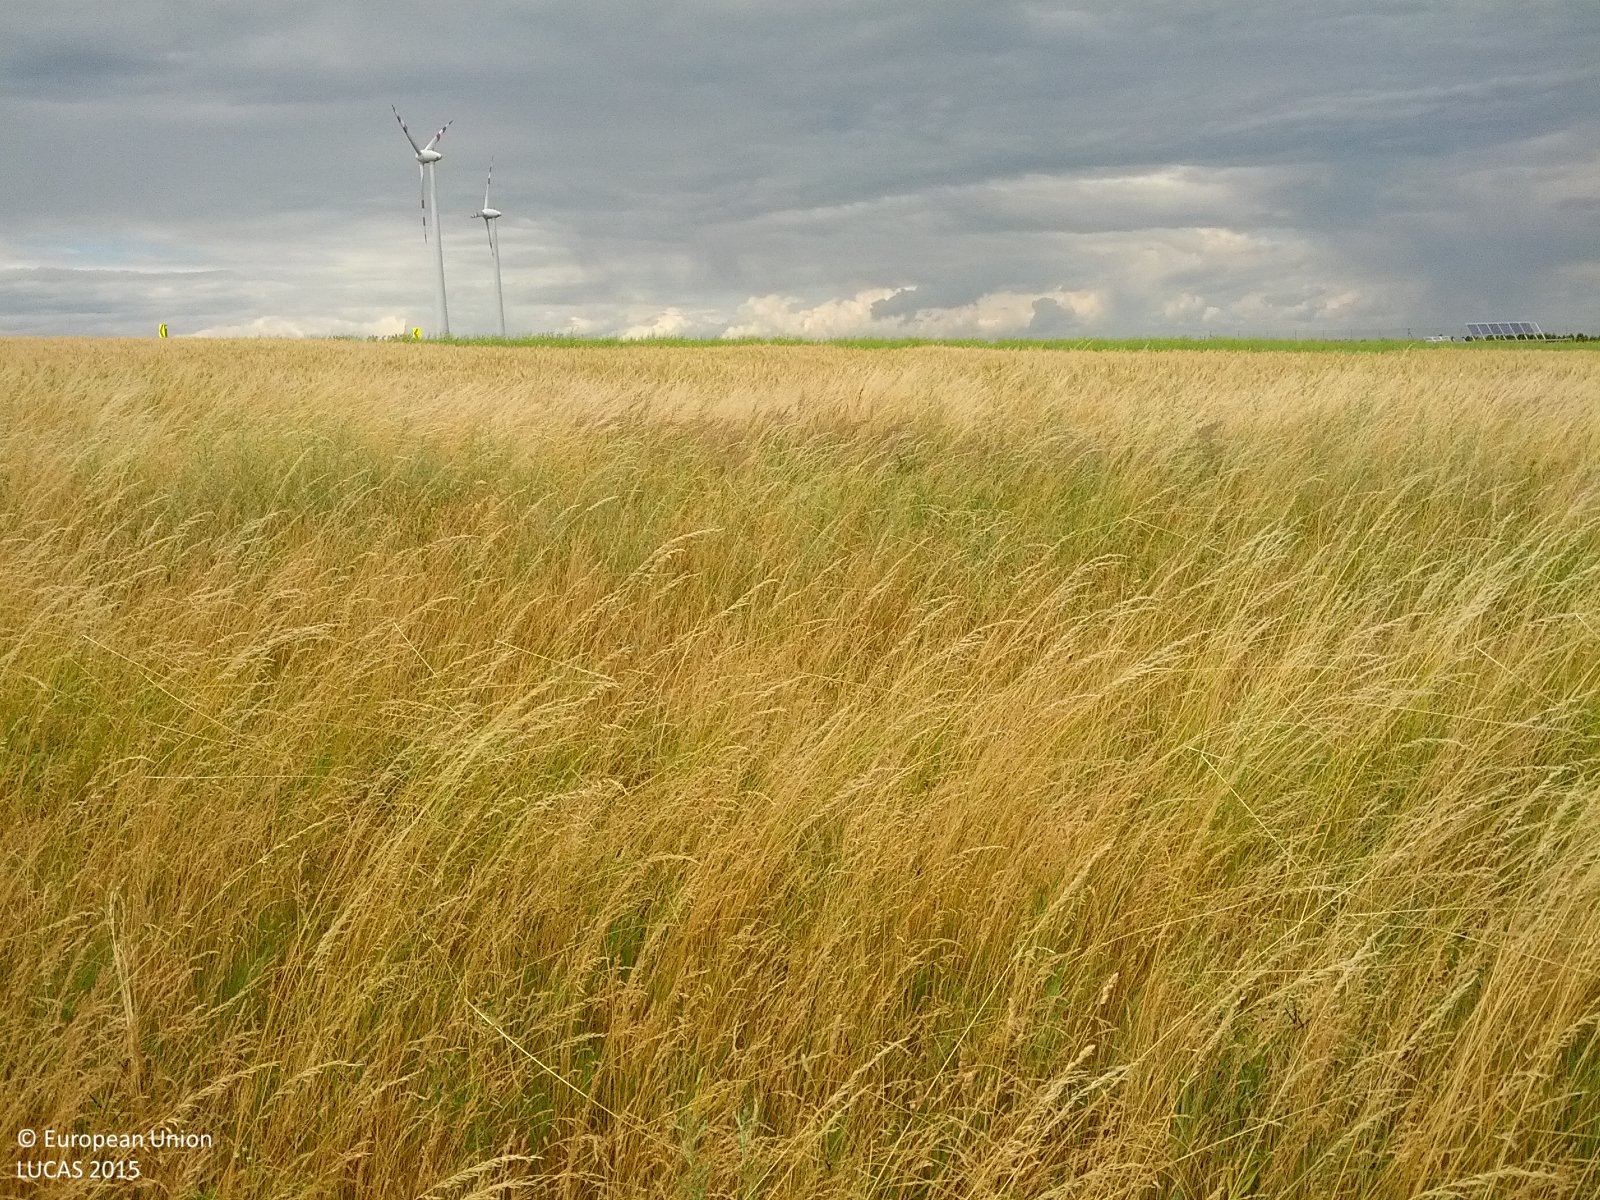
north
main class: Grassland
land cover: Grassland without tree/shrub cover
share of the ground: > 75 %
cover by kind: herbaceous plants 100 %
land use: Agriculture (excluding fallow land and kitchen gardens)
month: June
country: AT
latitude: 48.2755
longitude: 16.6490
